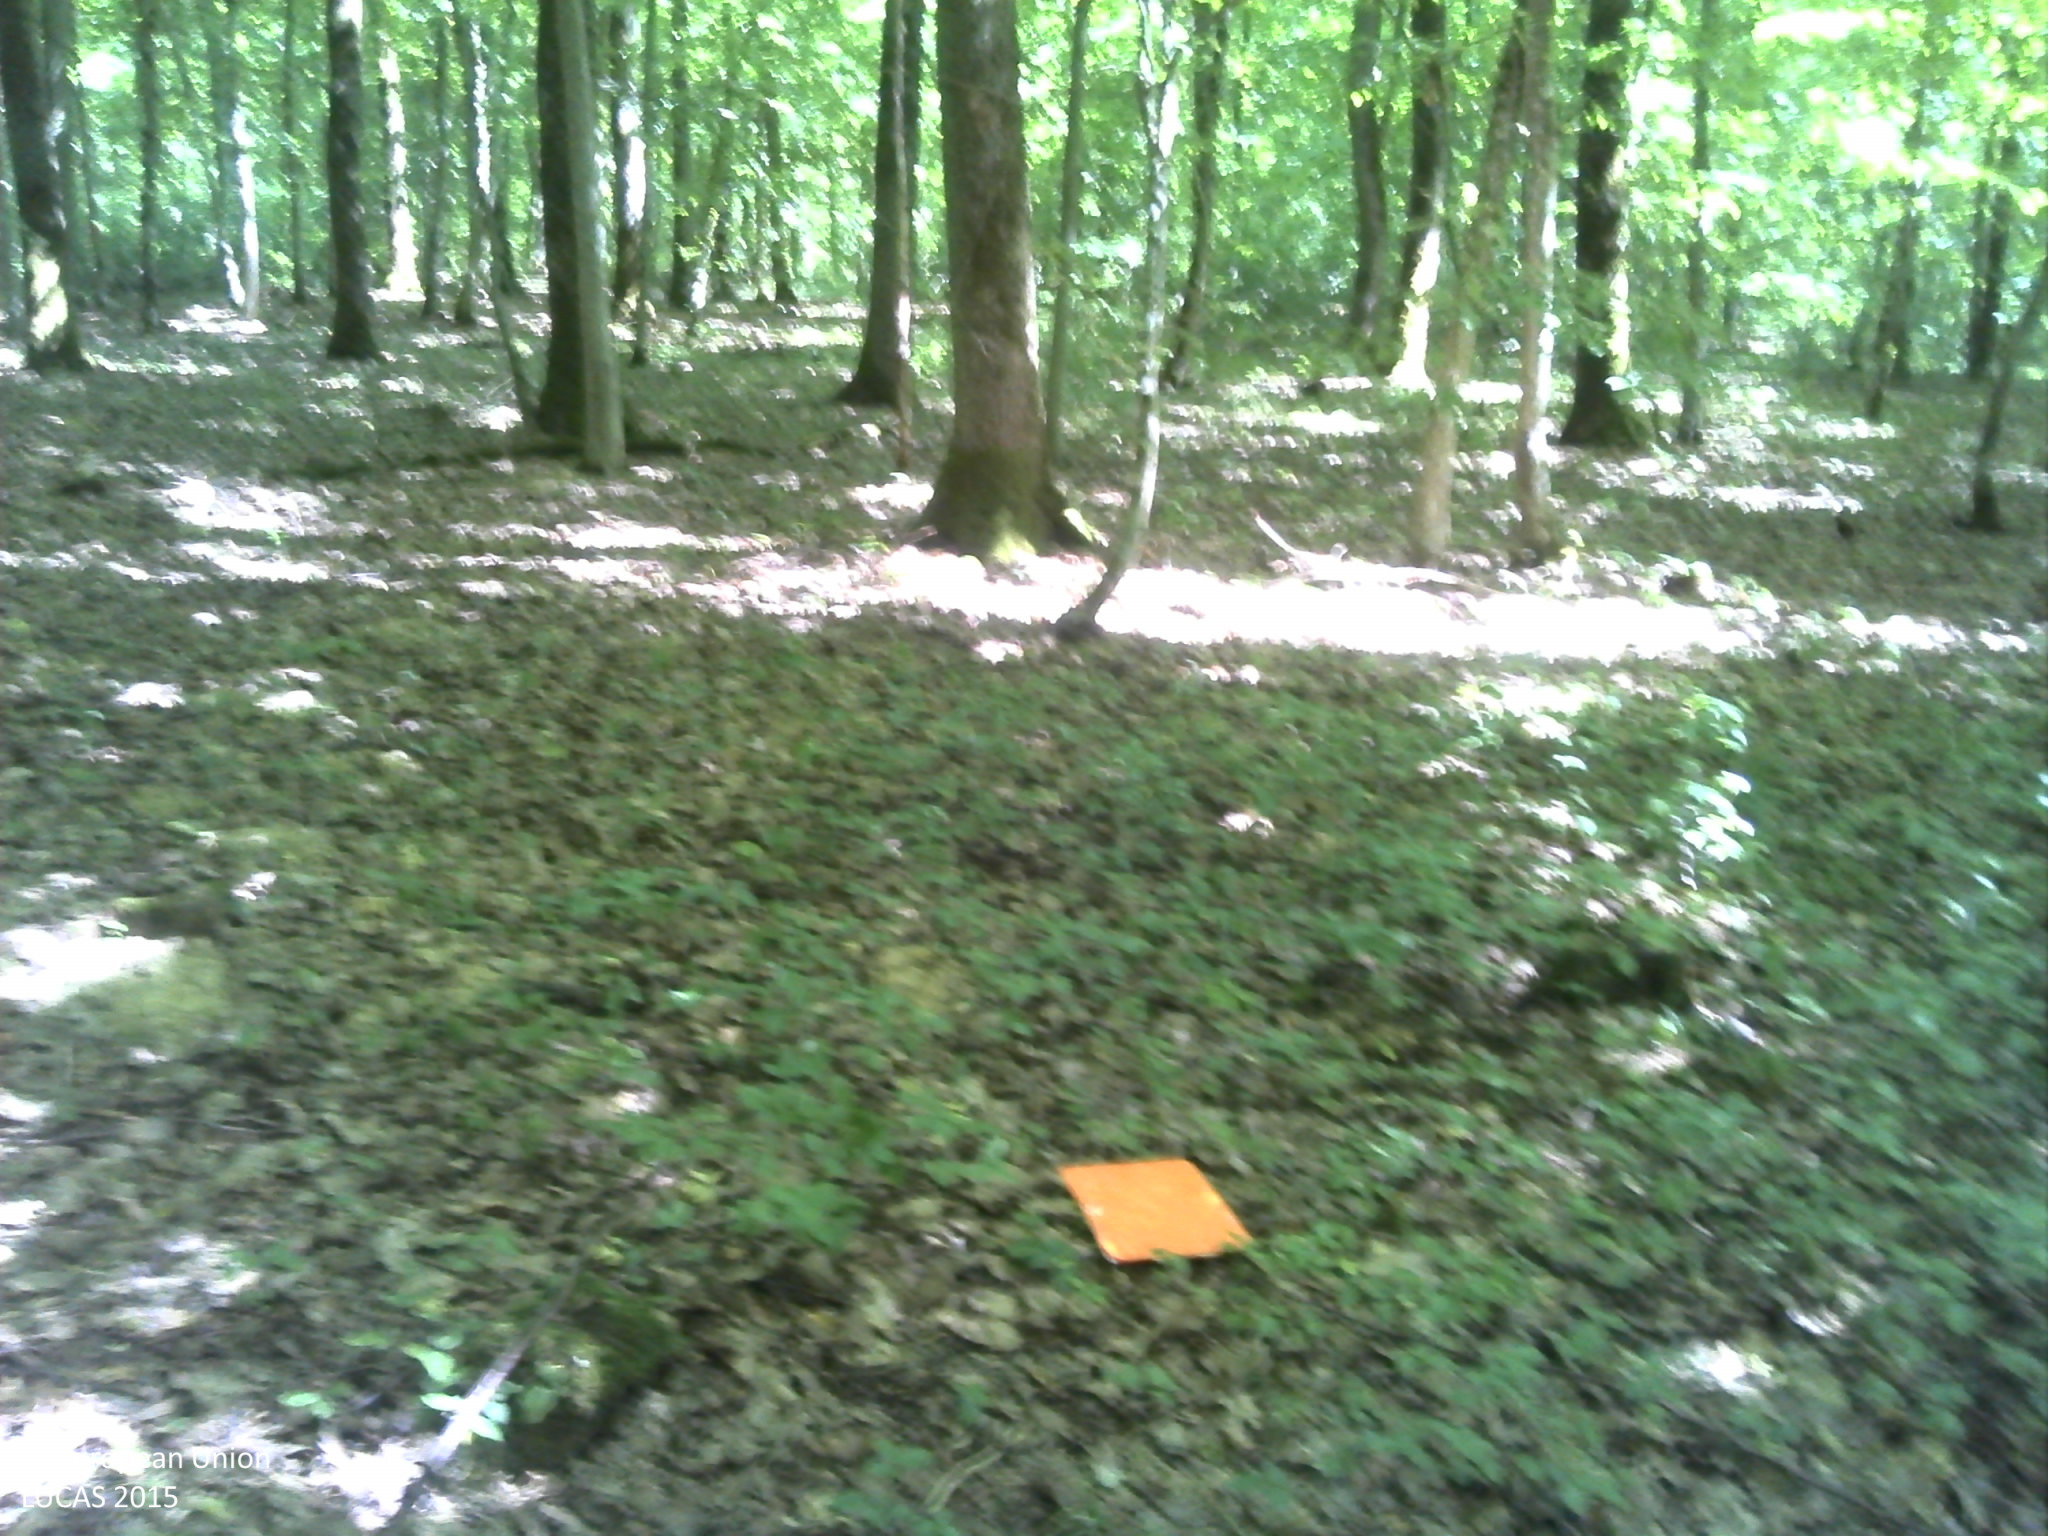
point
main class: Woodland
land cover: Broadleaved woodland
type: mesophytic deciduous forest
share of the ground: > 75 %
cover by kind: broadleaved forest trees 100 %
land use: Forestry
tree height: > 5 m
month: July
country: FR
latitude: 49.4711
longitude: 6.1494
